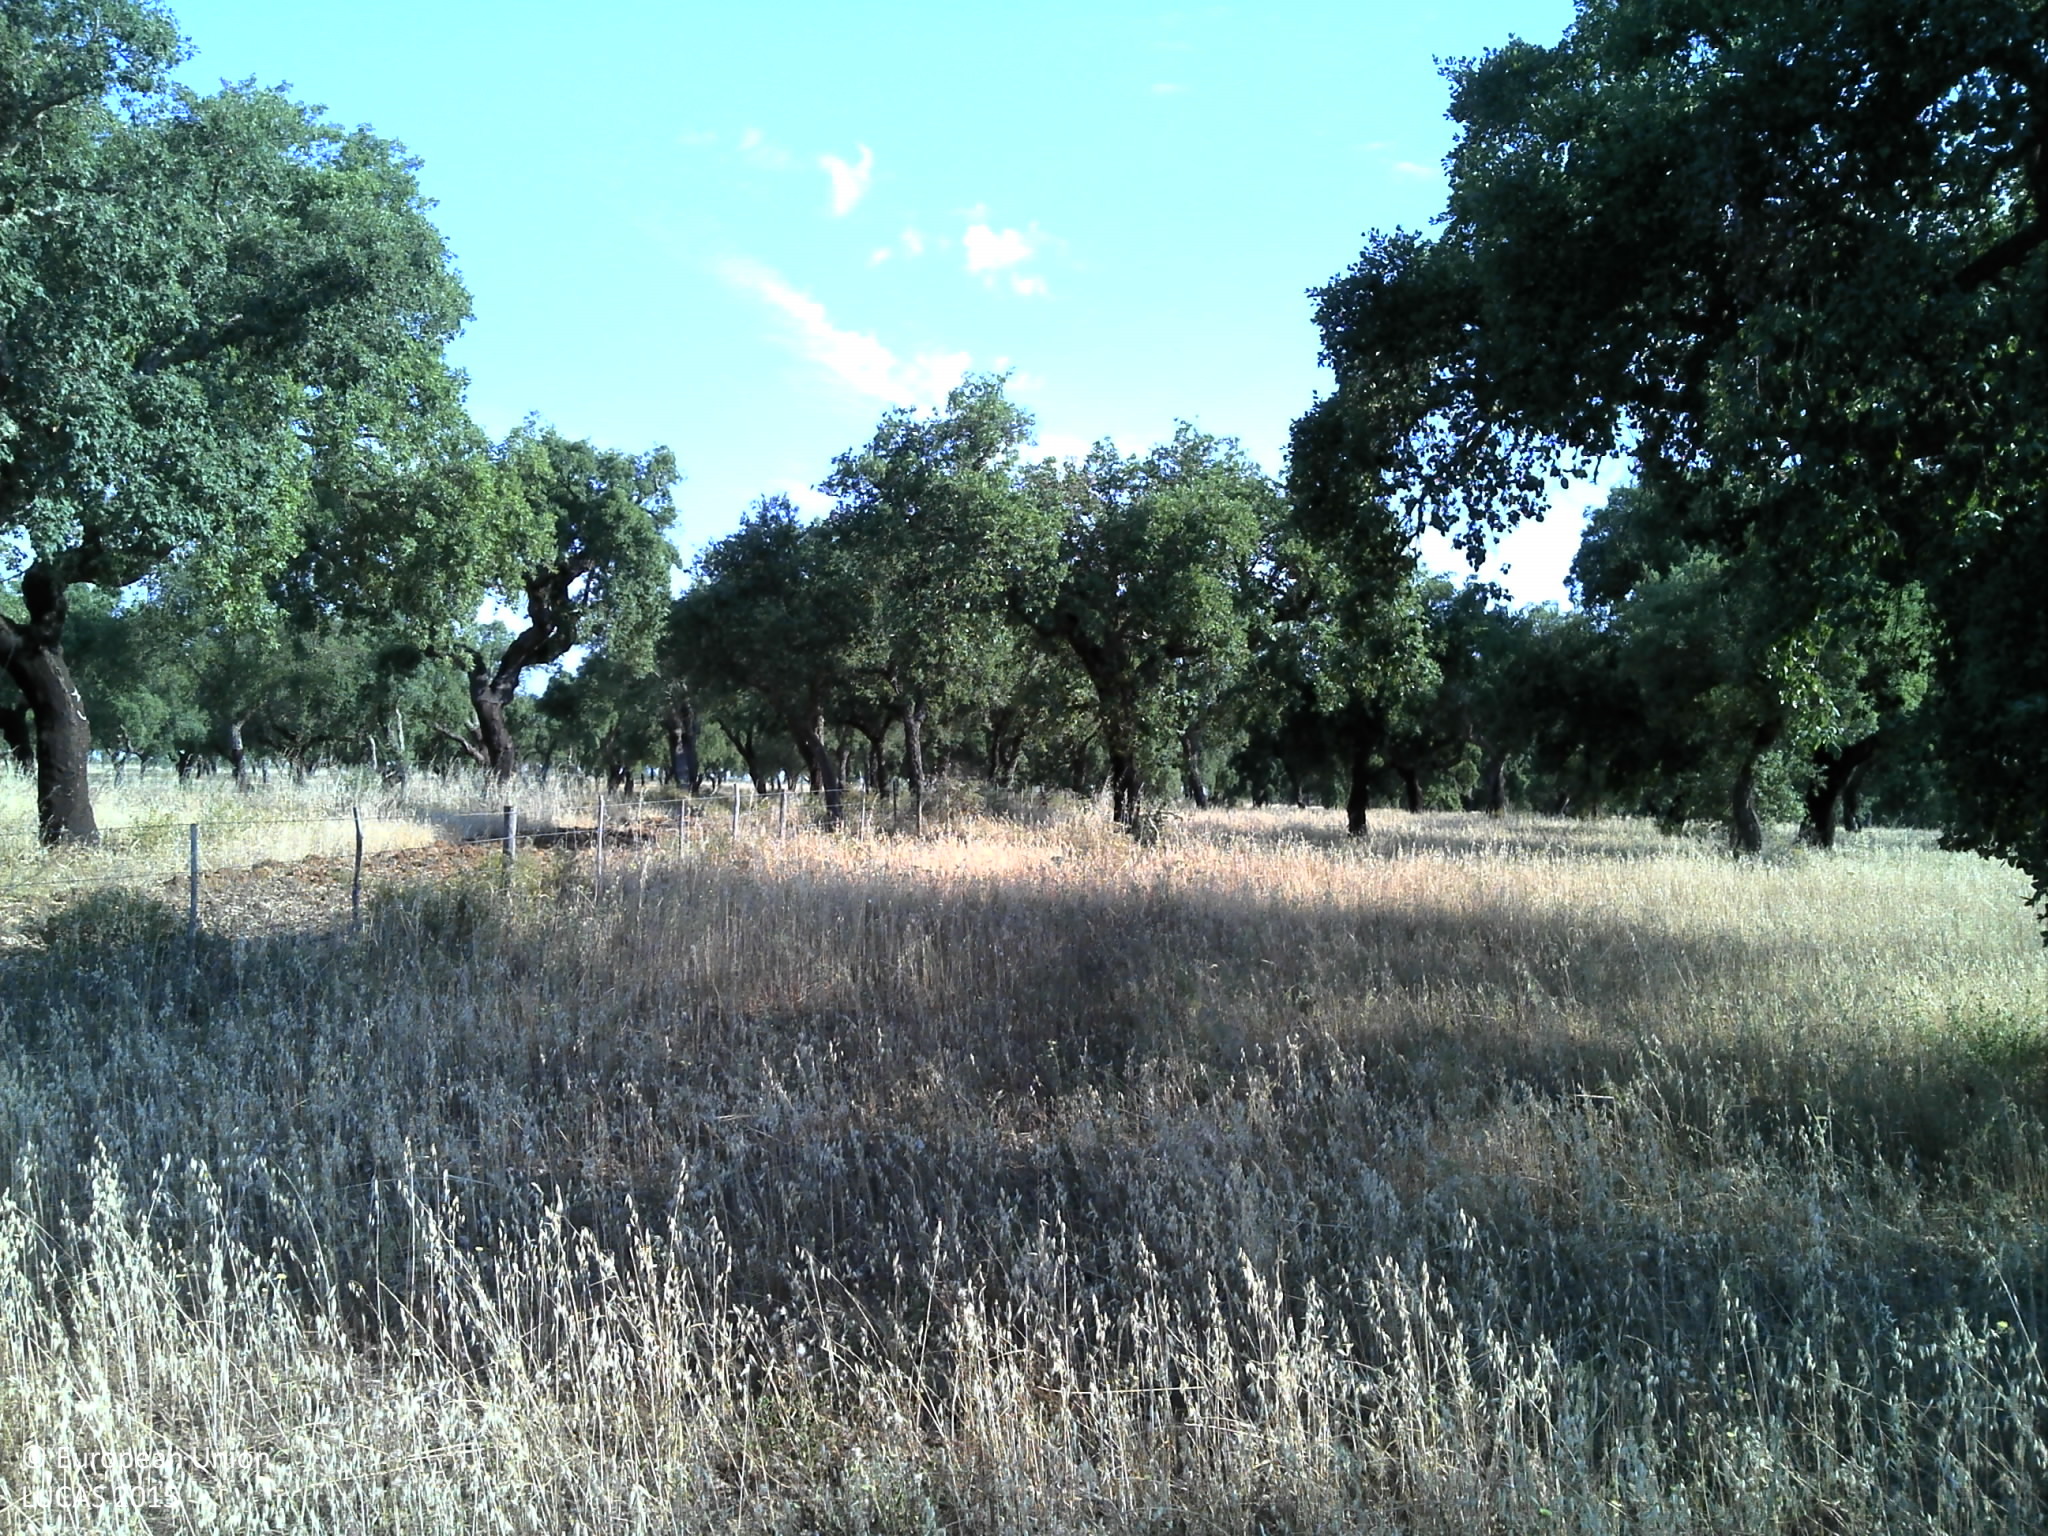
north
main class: Woodland
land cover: Broadleaved woodland
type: broadleaved evergreen forest
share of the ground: 25 - 50 %
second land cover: Oats
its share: 50 - 75 %
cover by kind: herbaceous plants 60 %, broadleaved forest trees 30 %, unconsolidated bare surface 10 %
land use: Forestry
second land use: Agriculture (excluding fallow land and kitchen gardens)
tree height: > 5 m
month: May
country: PT
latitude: 38.9173
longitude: -7.8166
